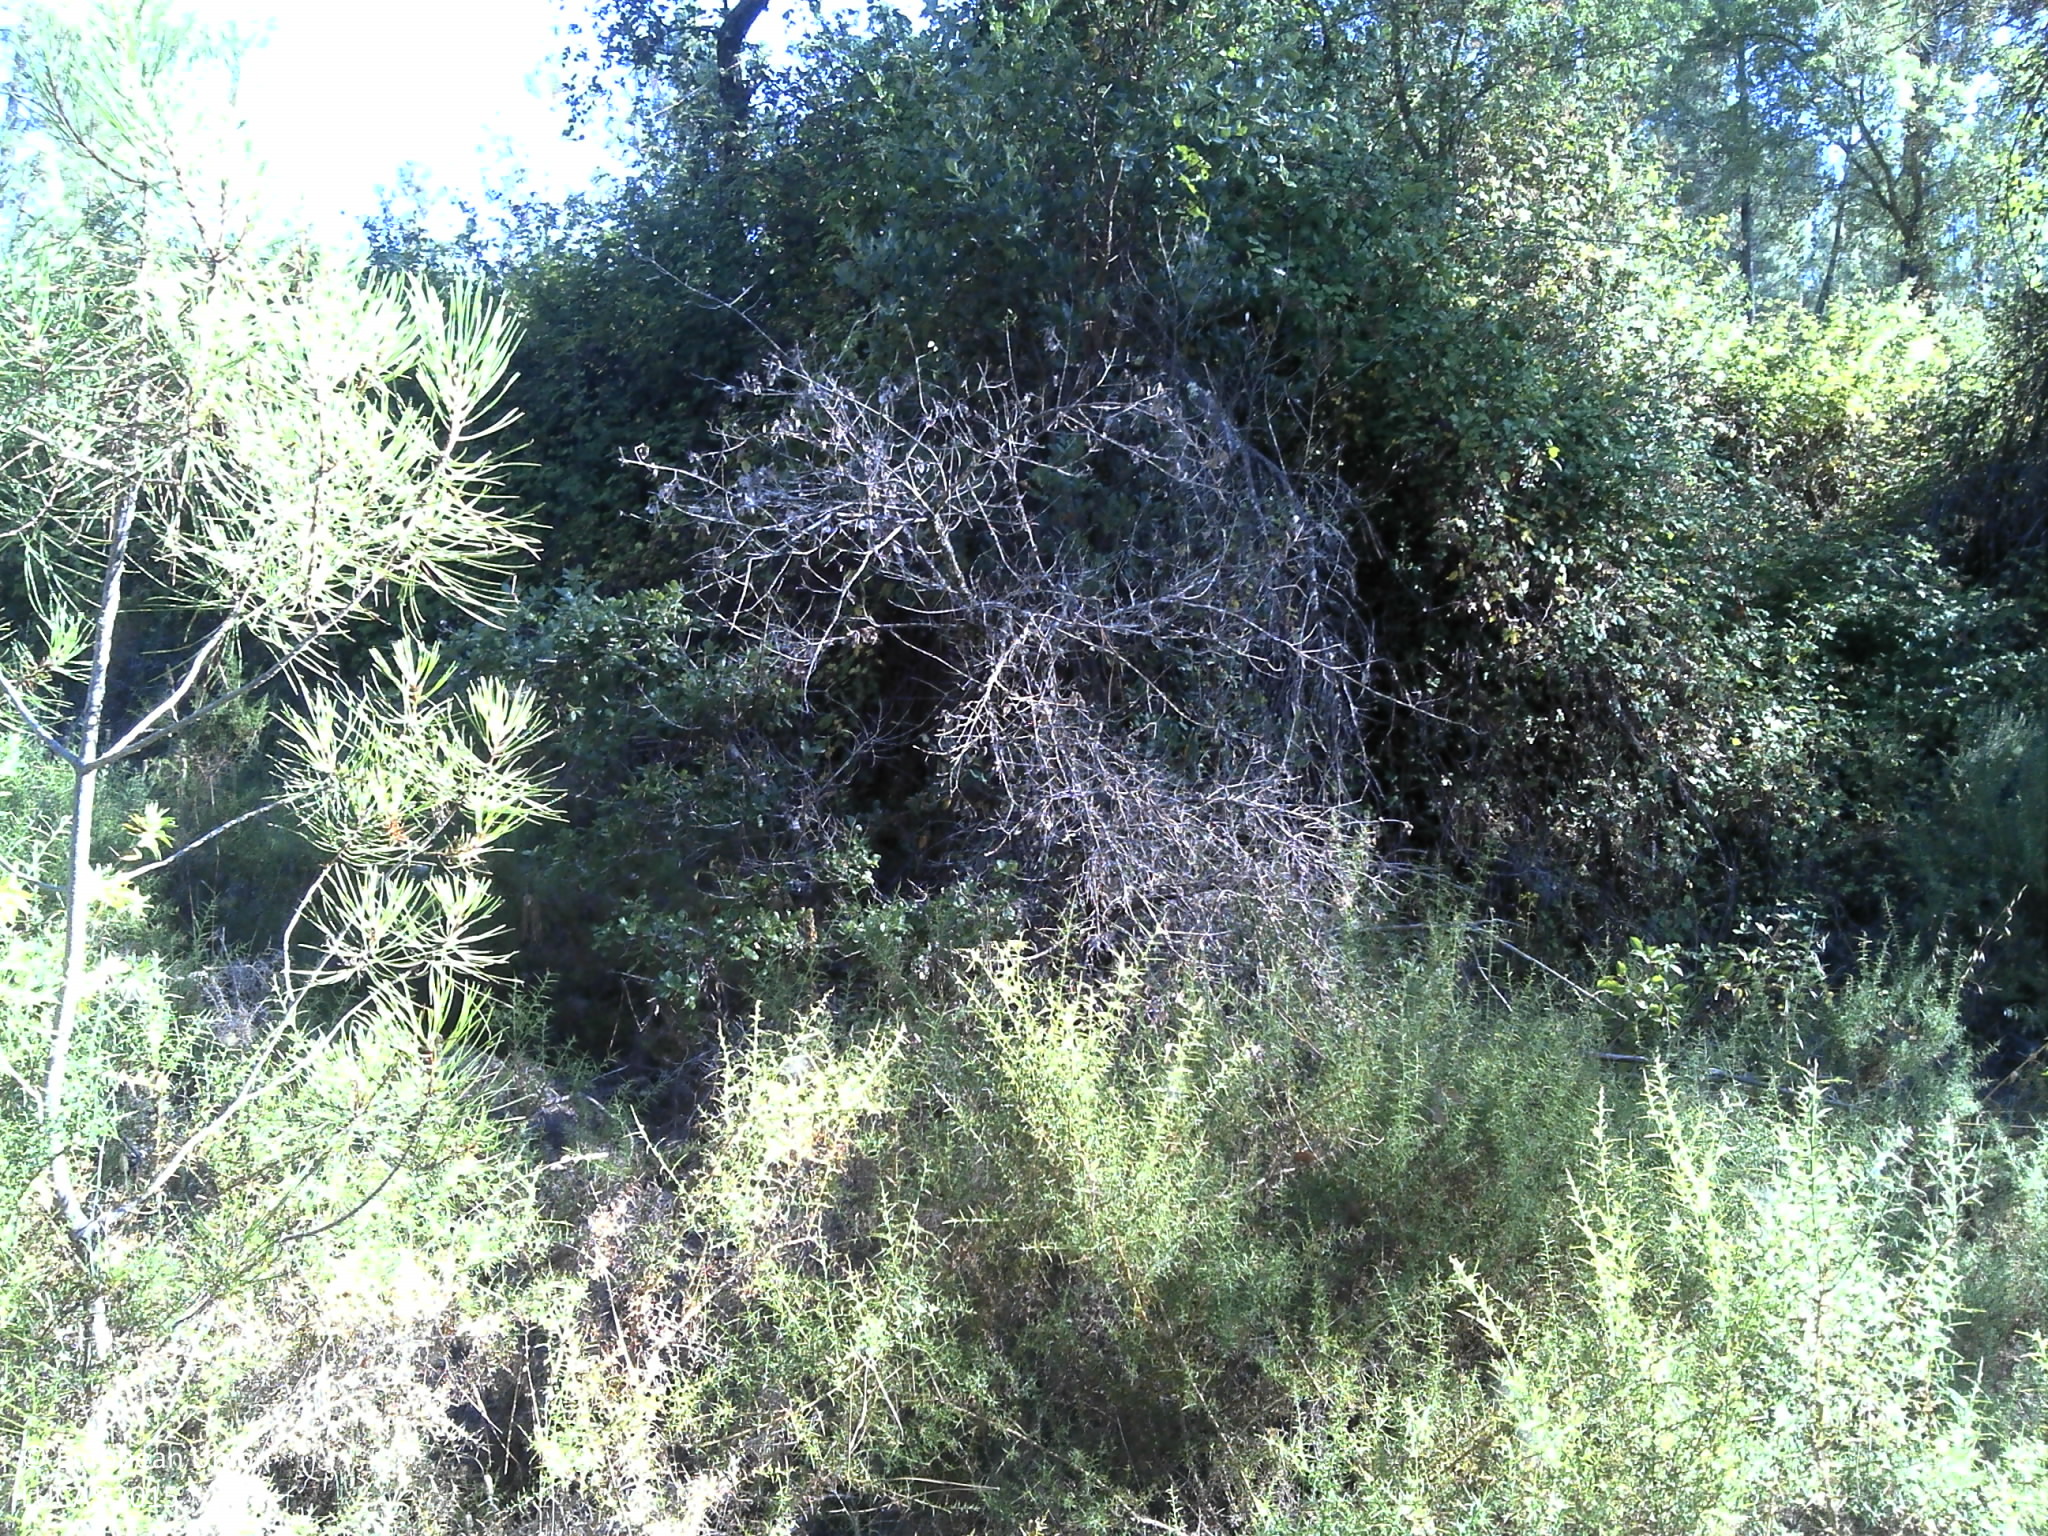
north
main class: Woodland
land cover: Pine dominated coniferous woodland
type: coniferous forest of the mediterranean region
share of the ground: 25 - 50 %
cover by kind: shrubs 75 %, coniferous forest trees 25 %
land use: Forestry
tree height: > 5 m
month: July
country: PT
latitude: 39.7646
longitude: -8.1259
